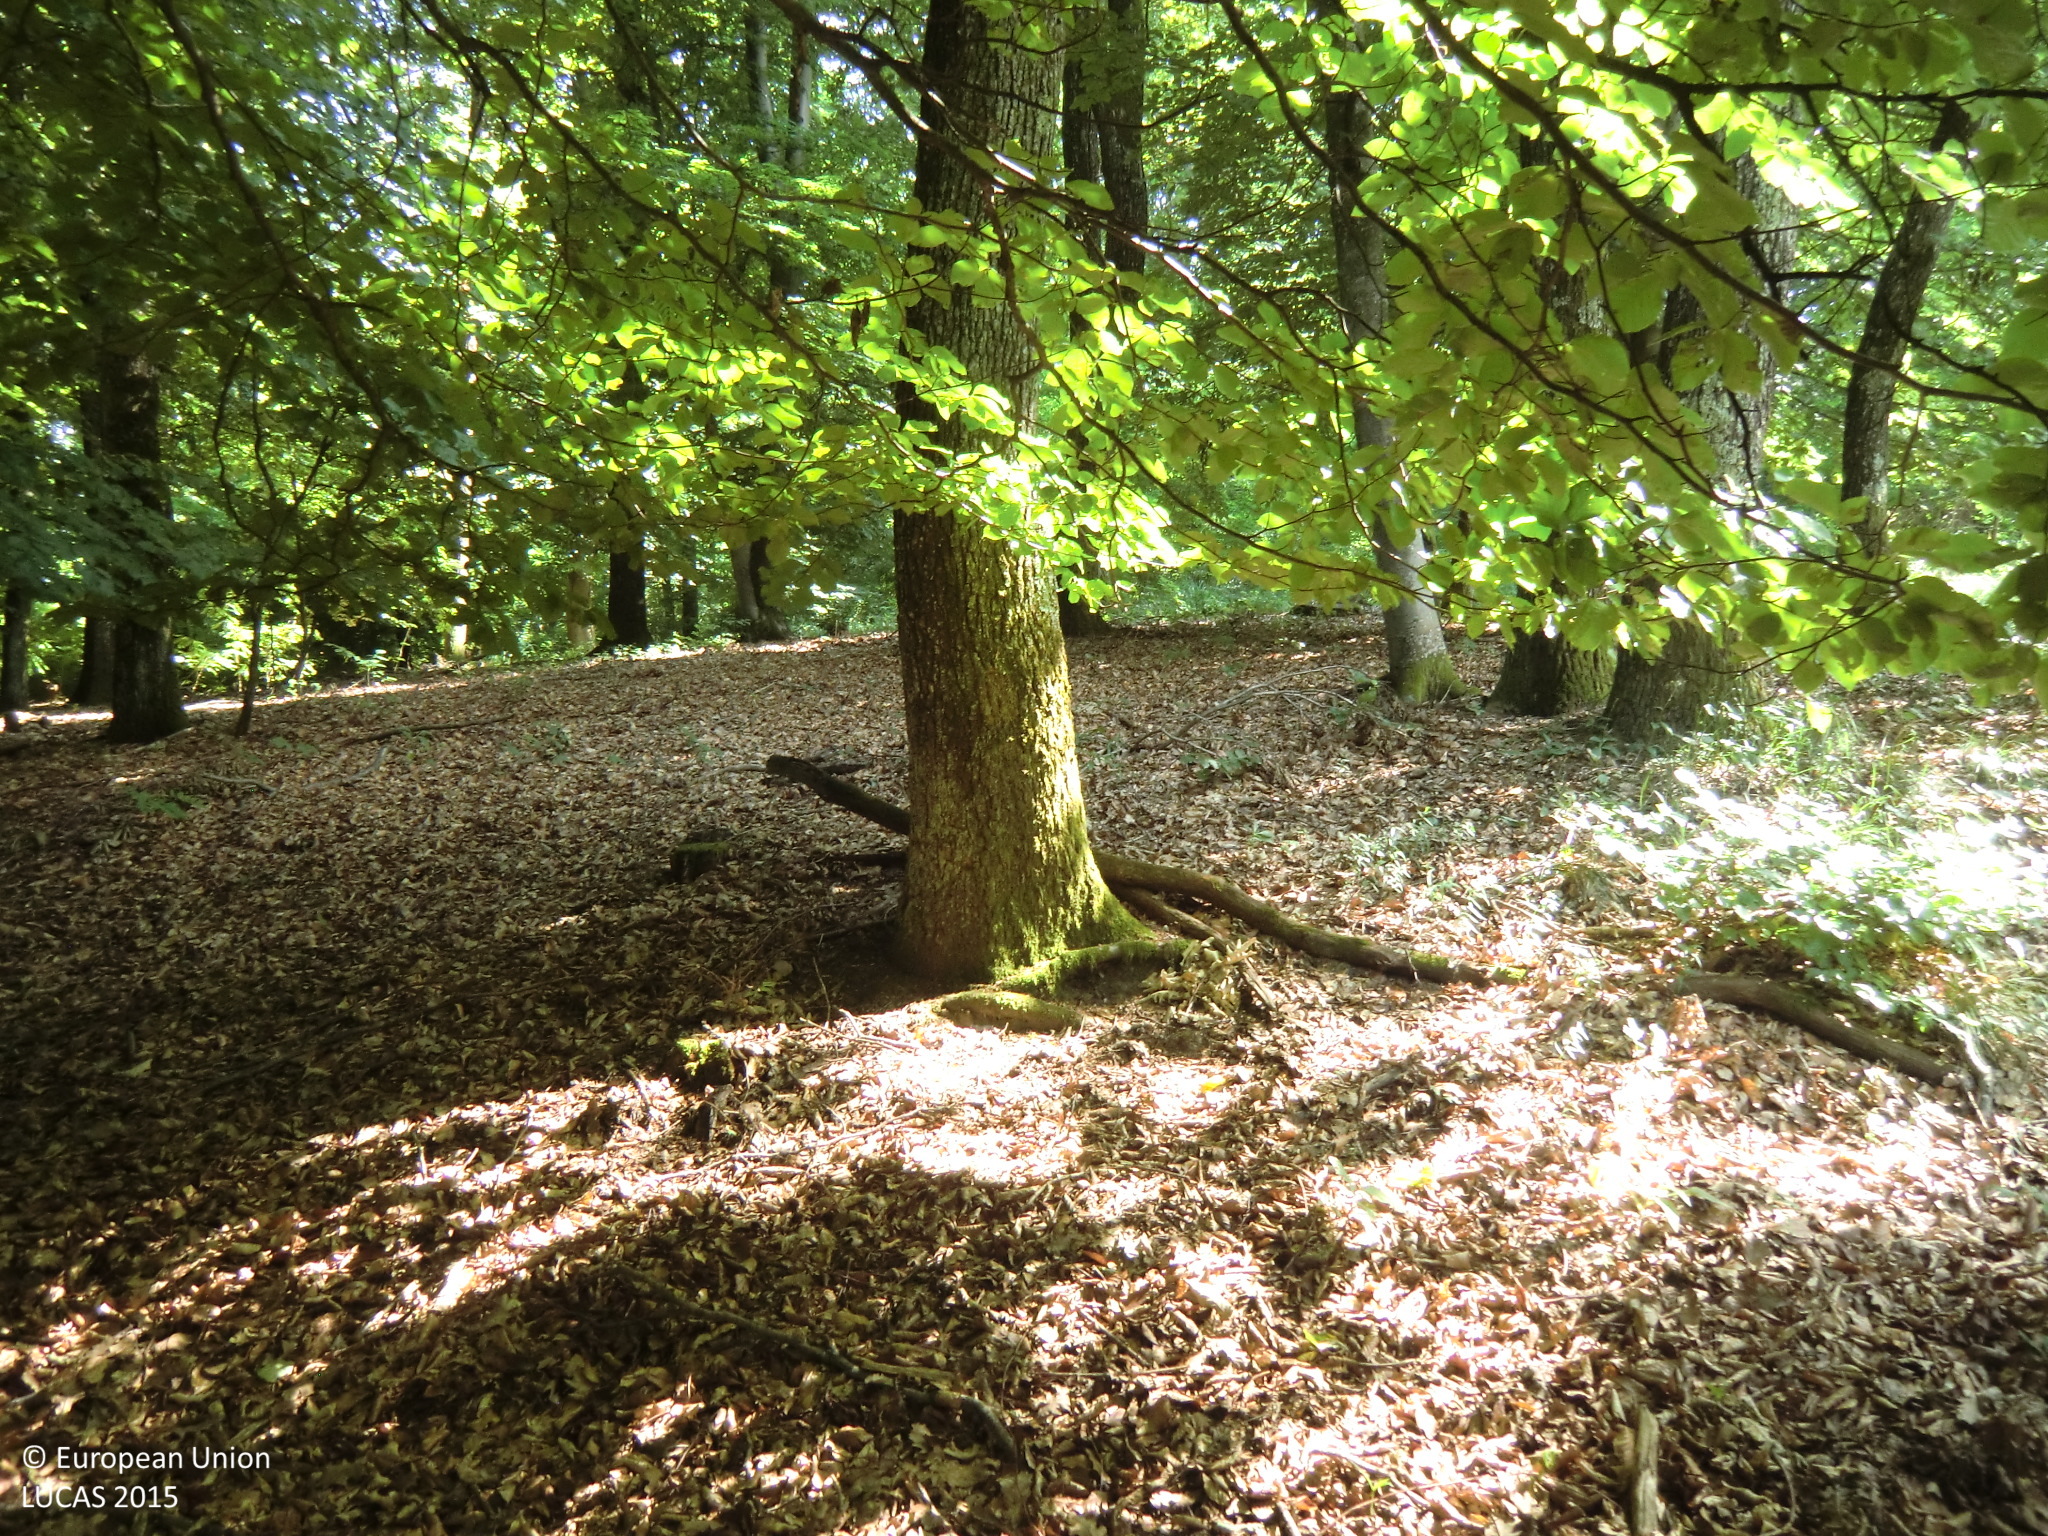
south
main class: Woodland
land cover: Broadleaved woodland
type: beech forest
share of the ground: > 75 %
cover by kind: broadleaved forest trees 80 %, herbaceous plants 10 %, unconsolidated bare surface 10 %
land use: Forestry
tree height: > 5 m
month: July
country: AT
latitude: 47.0142
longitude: 16.3030
